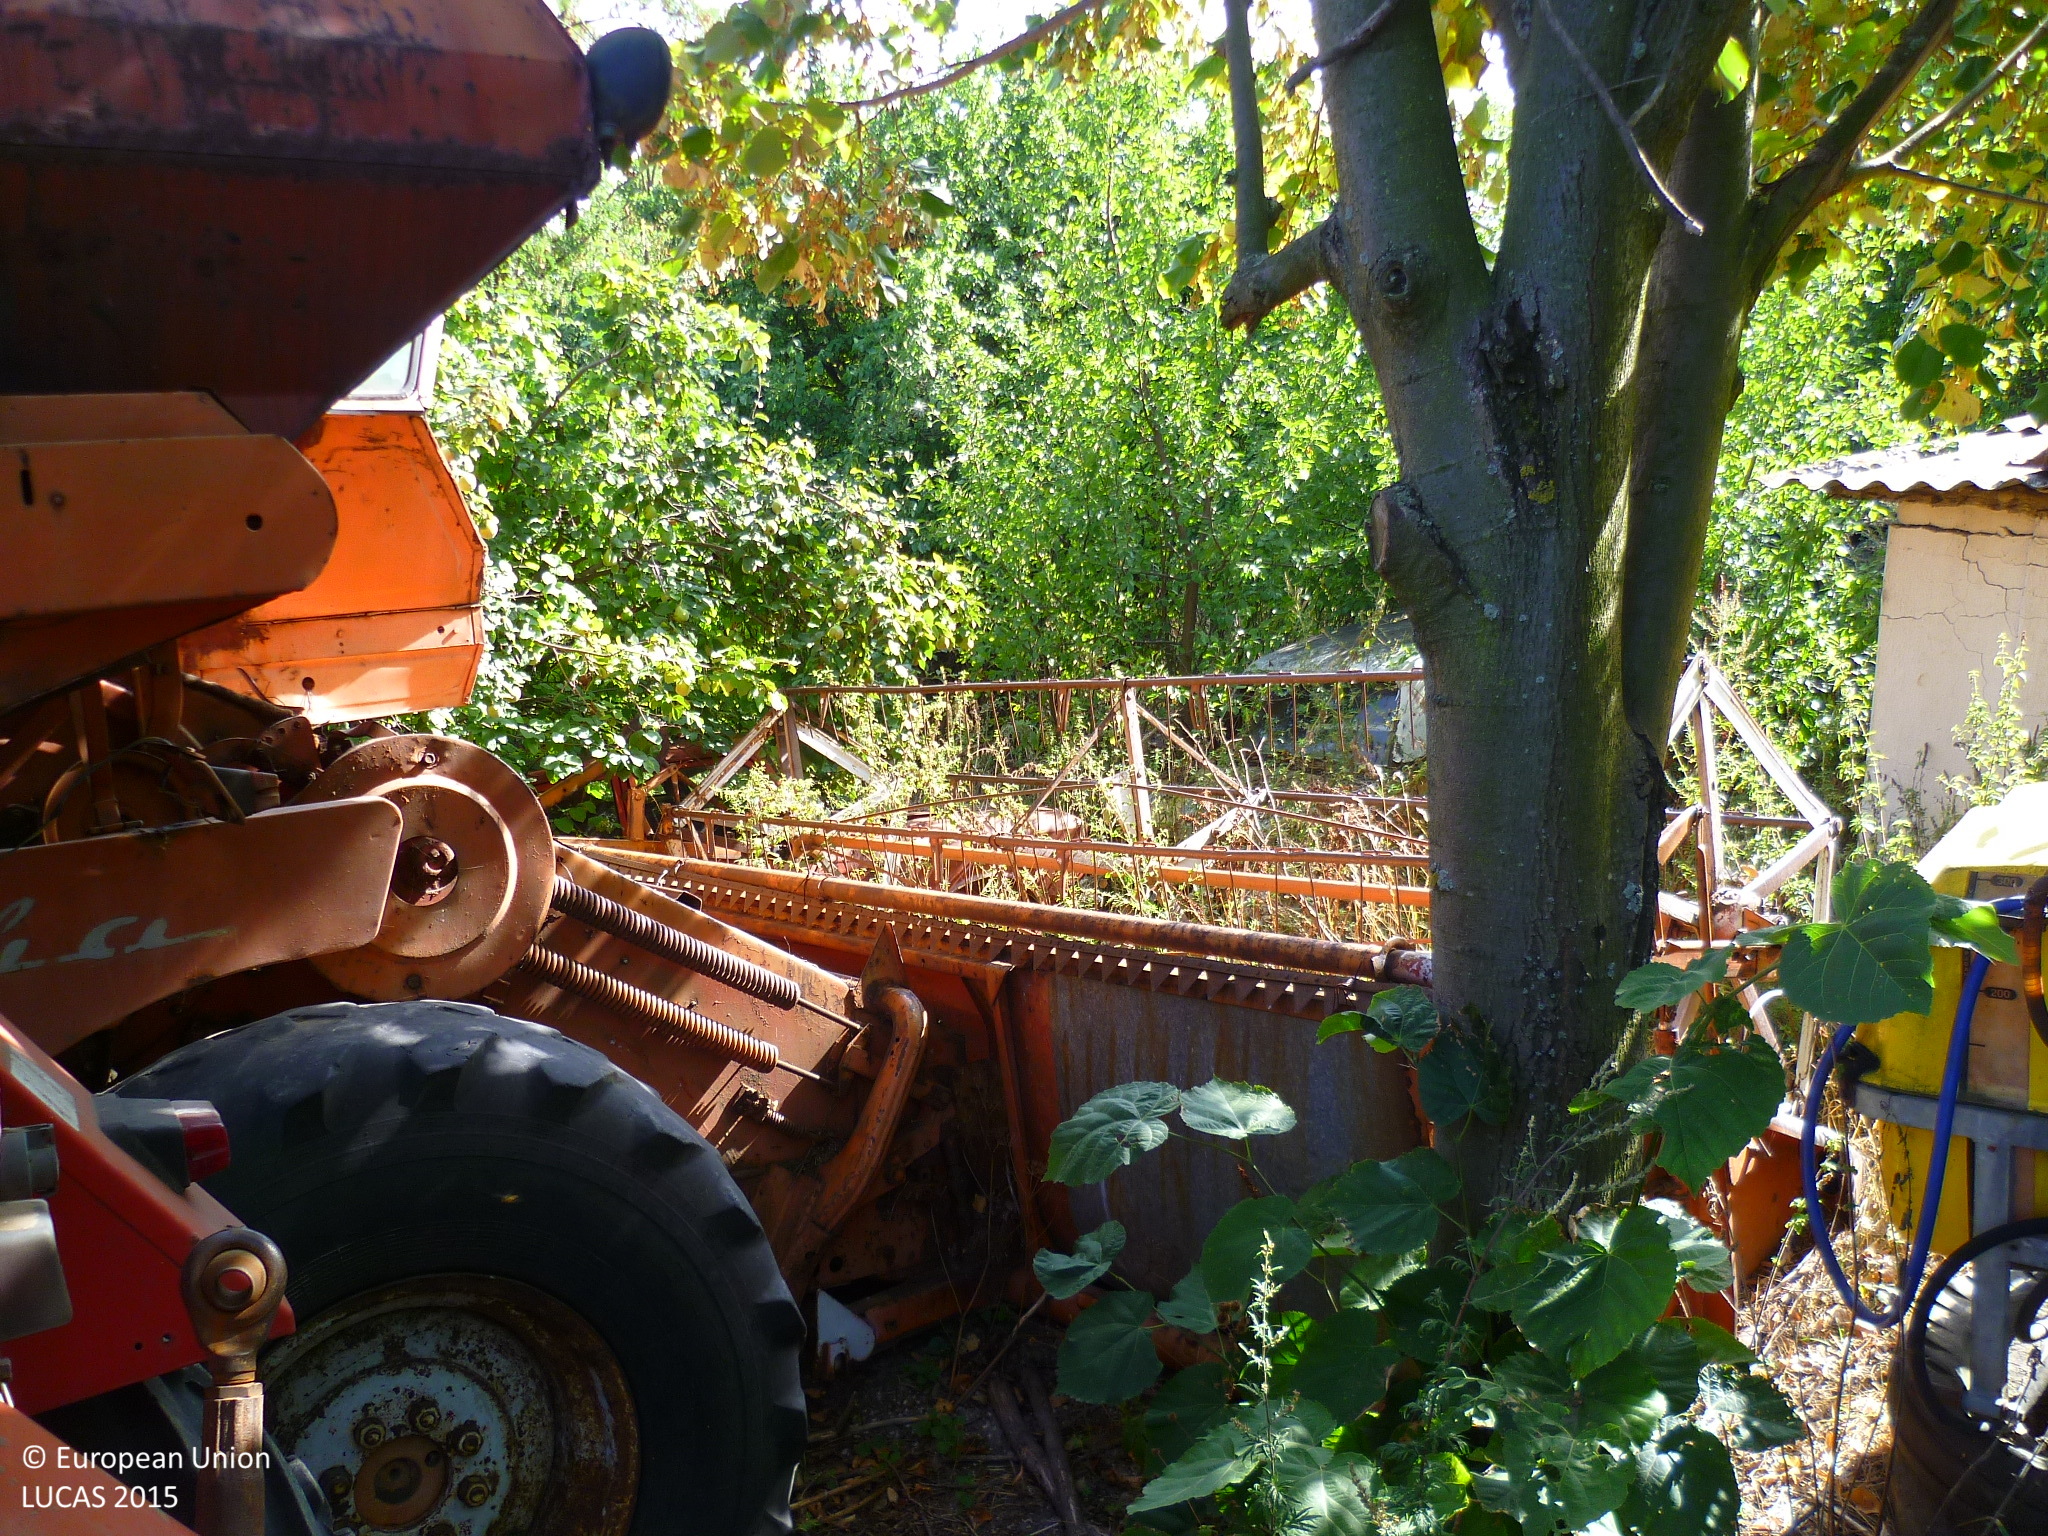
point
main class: Grassland
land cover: Grassland with sparse tree/shrub cover
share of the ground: 50 - 75 %
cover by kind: herbaceous plants 60 %, unconsolidated bare surface 30 %, broadleaved forest trees 5 %, shrubs 5 %
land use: Residential
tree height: > 5 m
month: September
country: BG
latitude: 42.6646
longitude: 23.0481
